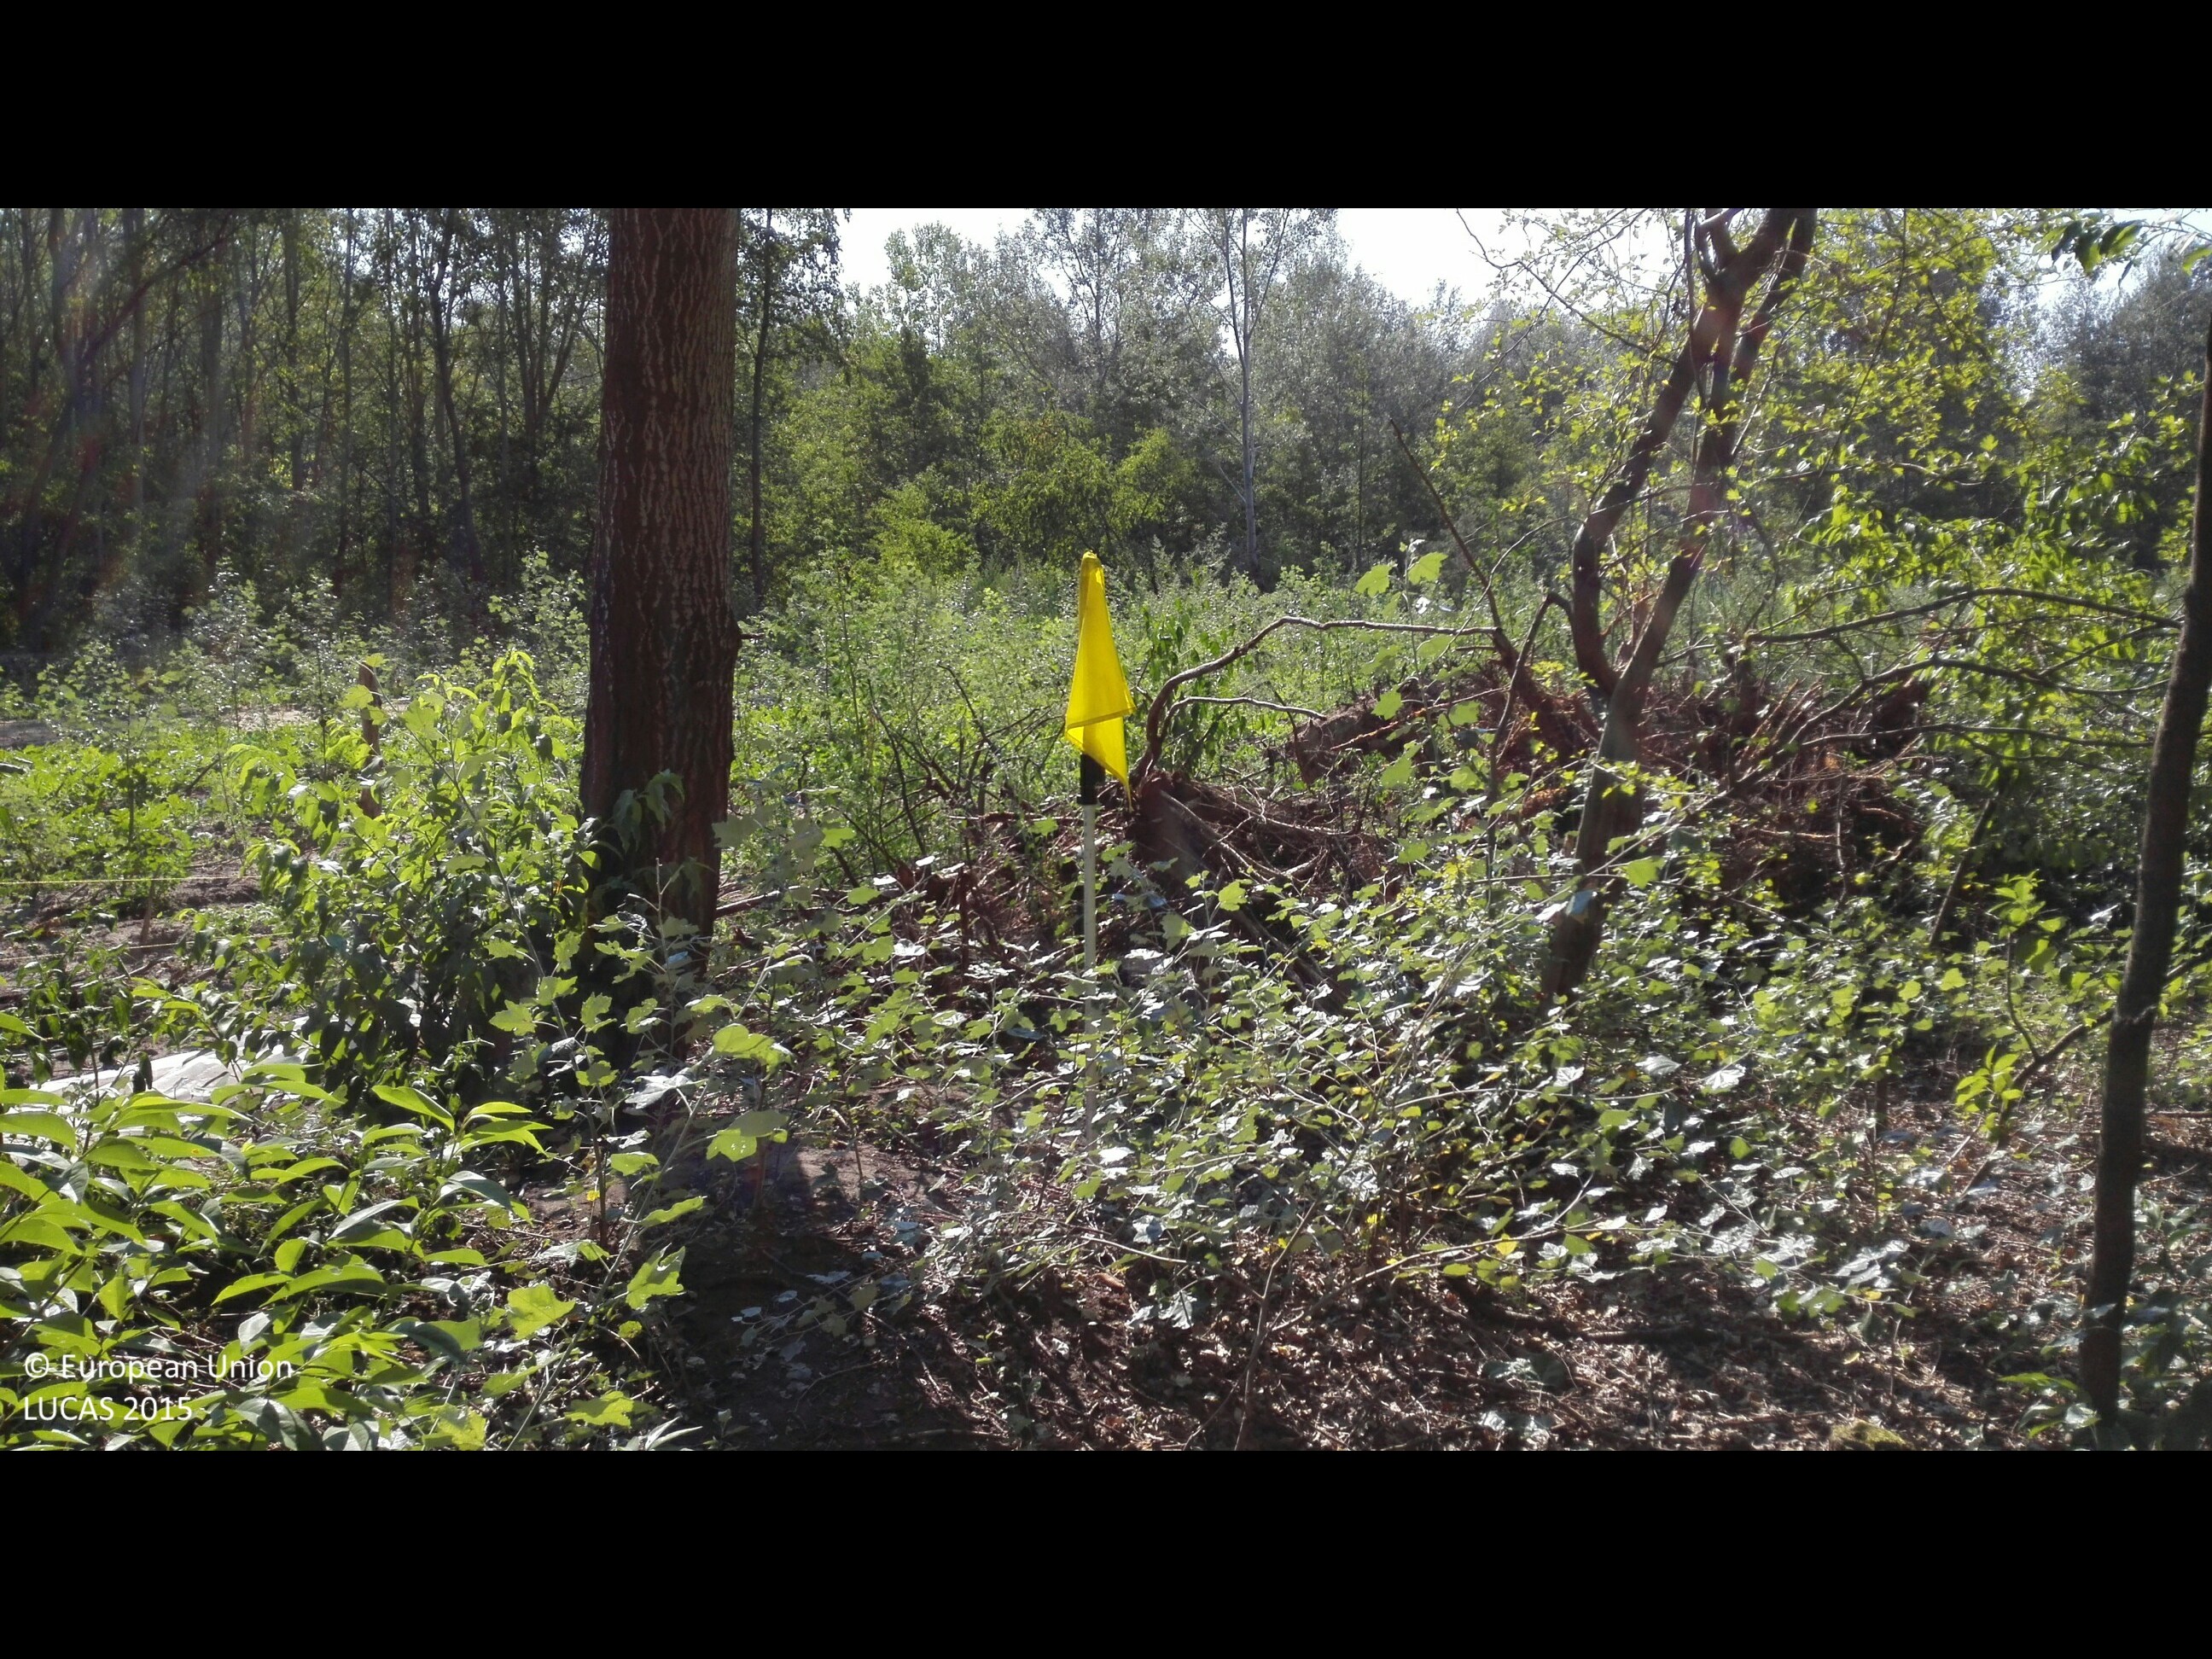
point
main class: Woodland
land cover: Broadleaved woodland
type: non-riverine alder, birch or aspen forest
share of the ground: > 75 %
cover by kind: broadleaved forest trees 80 %, herbaceous plants 15 %, shrubs 5 %
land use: Forestry
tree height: > 5 m
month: August
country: HU
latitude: 47.5055
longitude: 21.7158
